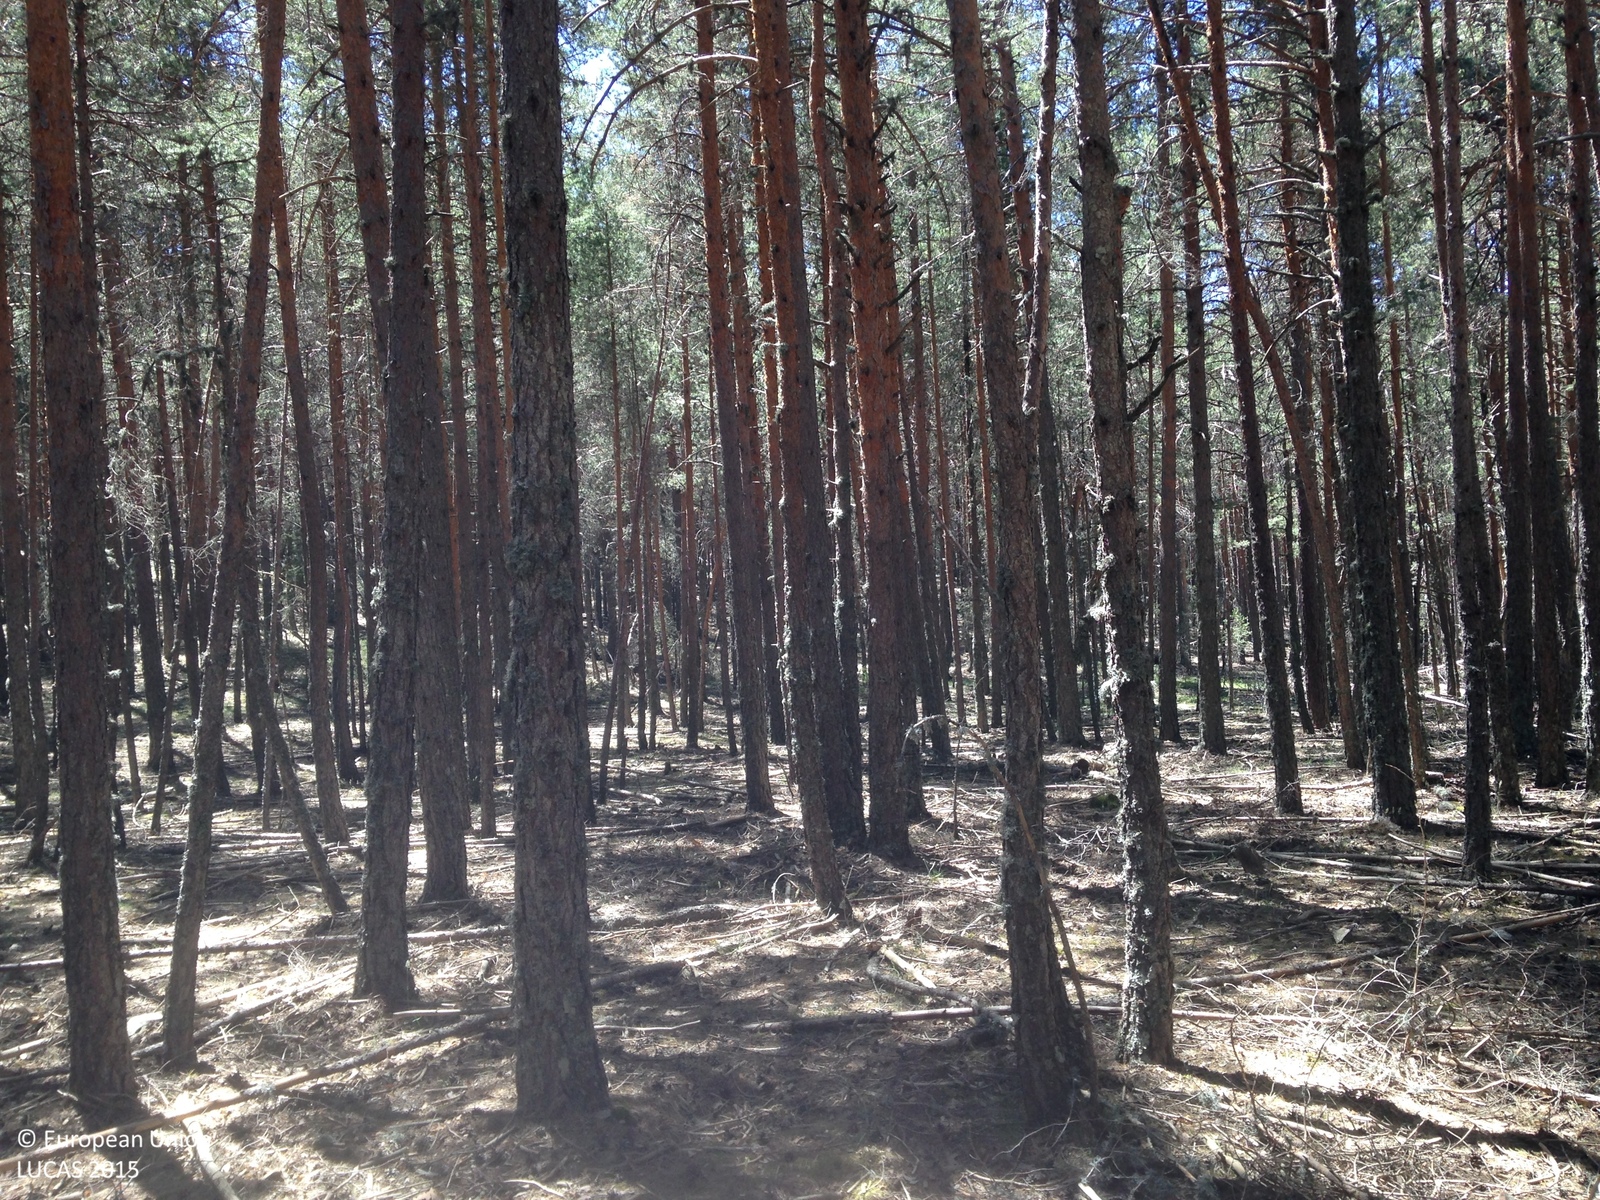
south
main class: Woodland
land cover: Pine dominated coniferous woodland
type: coniferous forest of the mediterranean region
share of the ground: > 75 %
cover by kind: coniferous forest trees 90 %
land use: Forestry
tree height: > 5 m
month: May
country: ES
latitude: 40.5530
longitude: -1.9825
